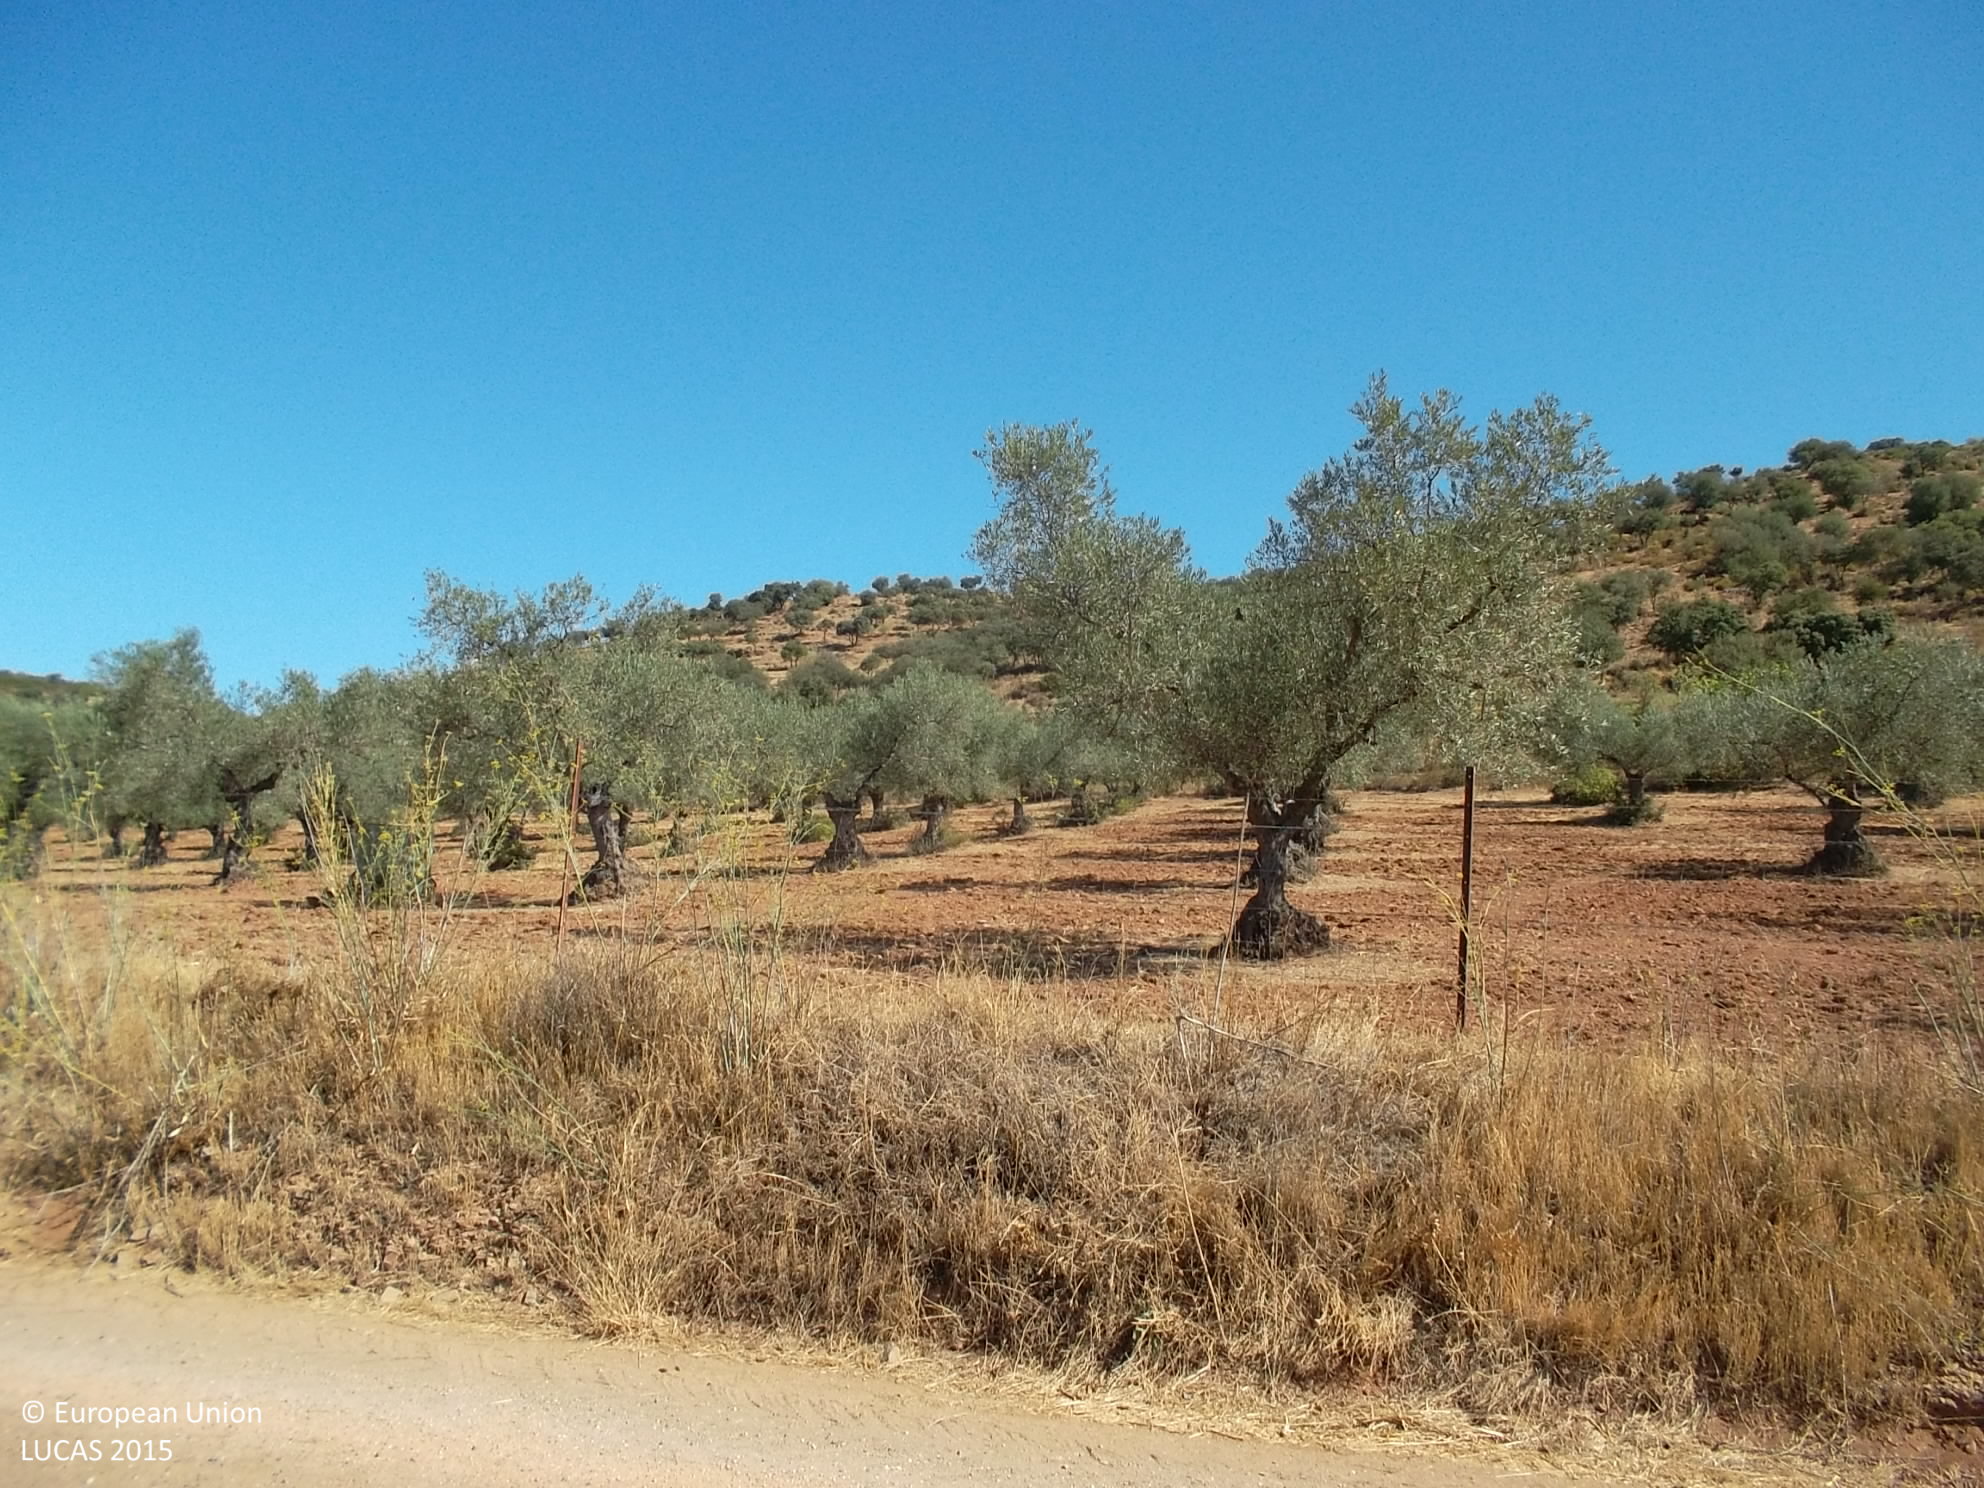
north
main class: Grassland
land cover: Grassland with sparse tree/shrub cover
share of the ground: > 75 %
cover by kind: herbaceous plants 90 %, broadleaved forest trees 5 %, shrubs 5 %
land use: Agriculture (excluding fallow land and kitchen gardens)
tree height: < 5 m
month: August
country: ES
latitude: 38.5194
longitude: -6.6530
